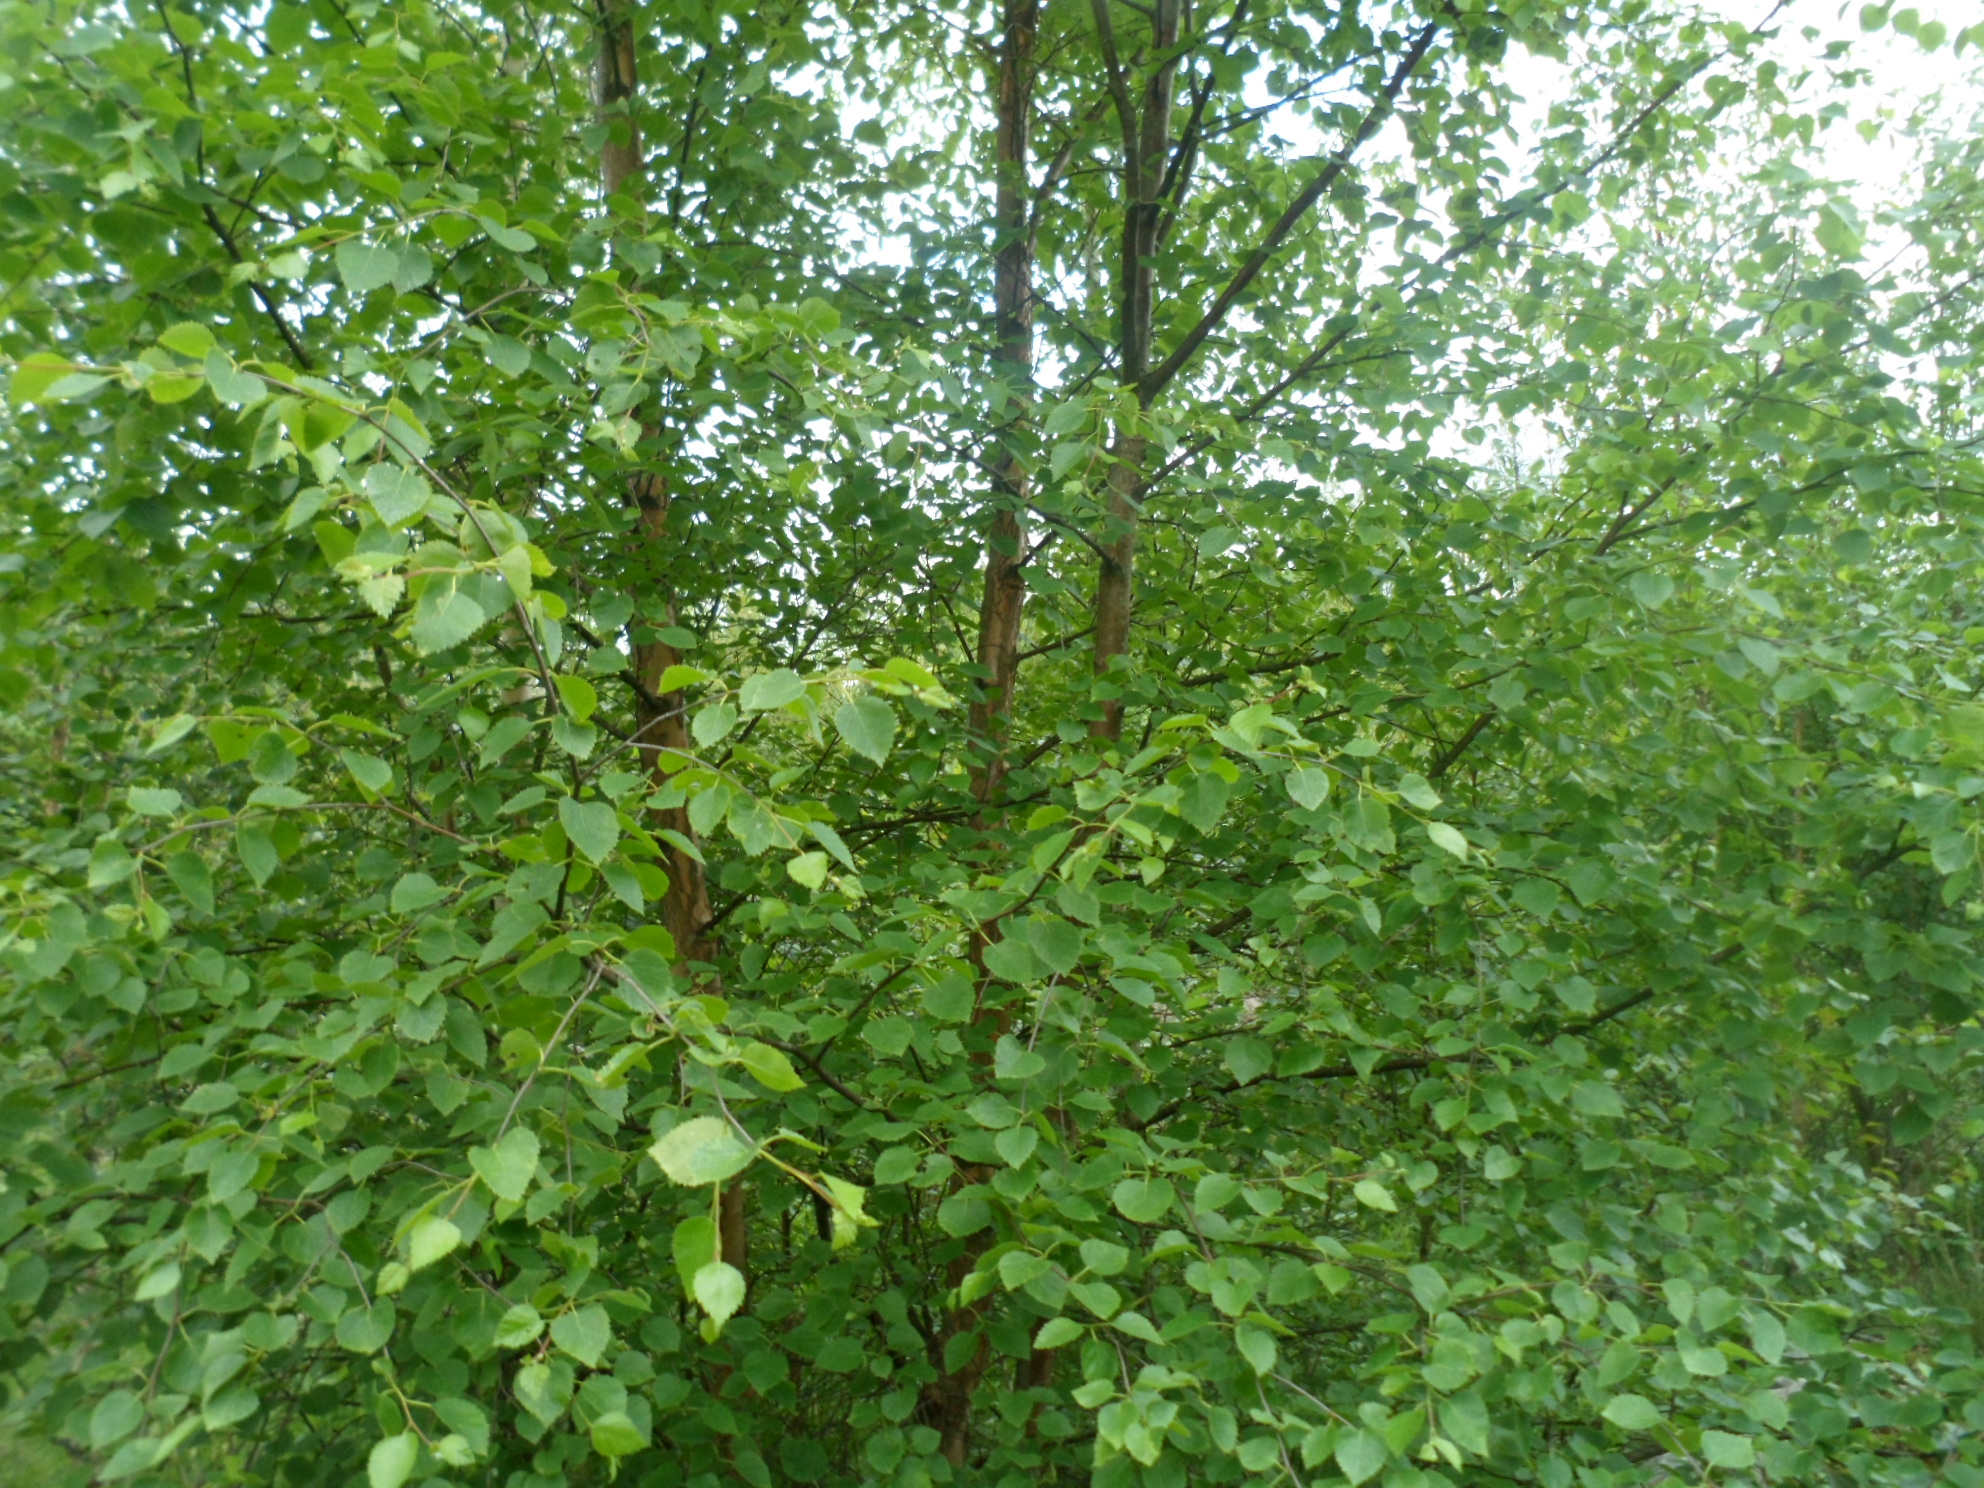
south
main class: Woodland
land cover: Spruce dominated mixed woodland
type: boreal forest
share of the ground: > 75 %
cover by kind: broadleaved forest trees 45 %, coniferous forest trees 35 %, herbaceous plants 15 %, shrubs 5 %
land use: Forestry
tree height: < 5 m
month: June
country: SE
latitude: 57.0912
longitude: 14.2046
